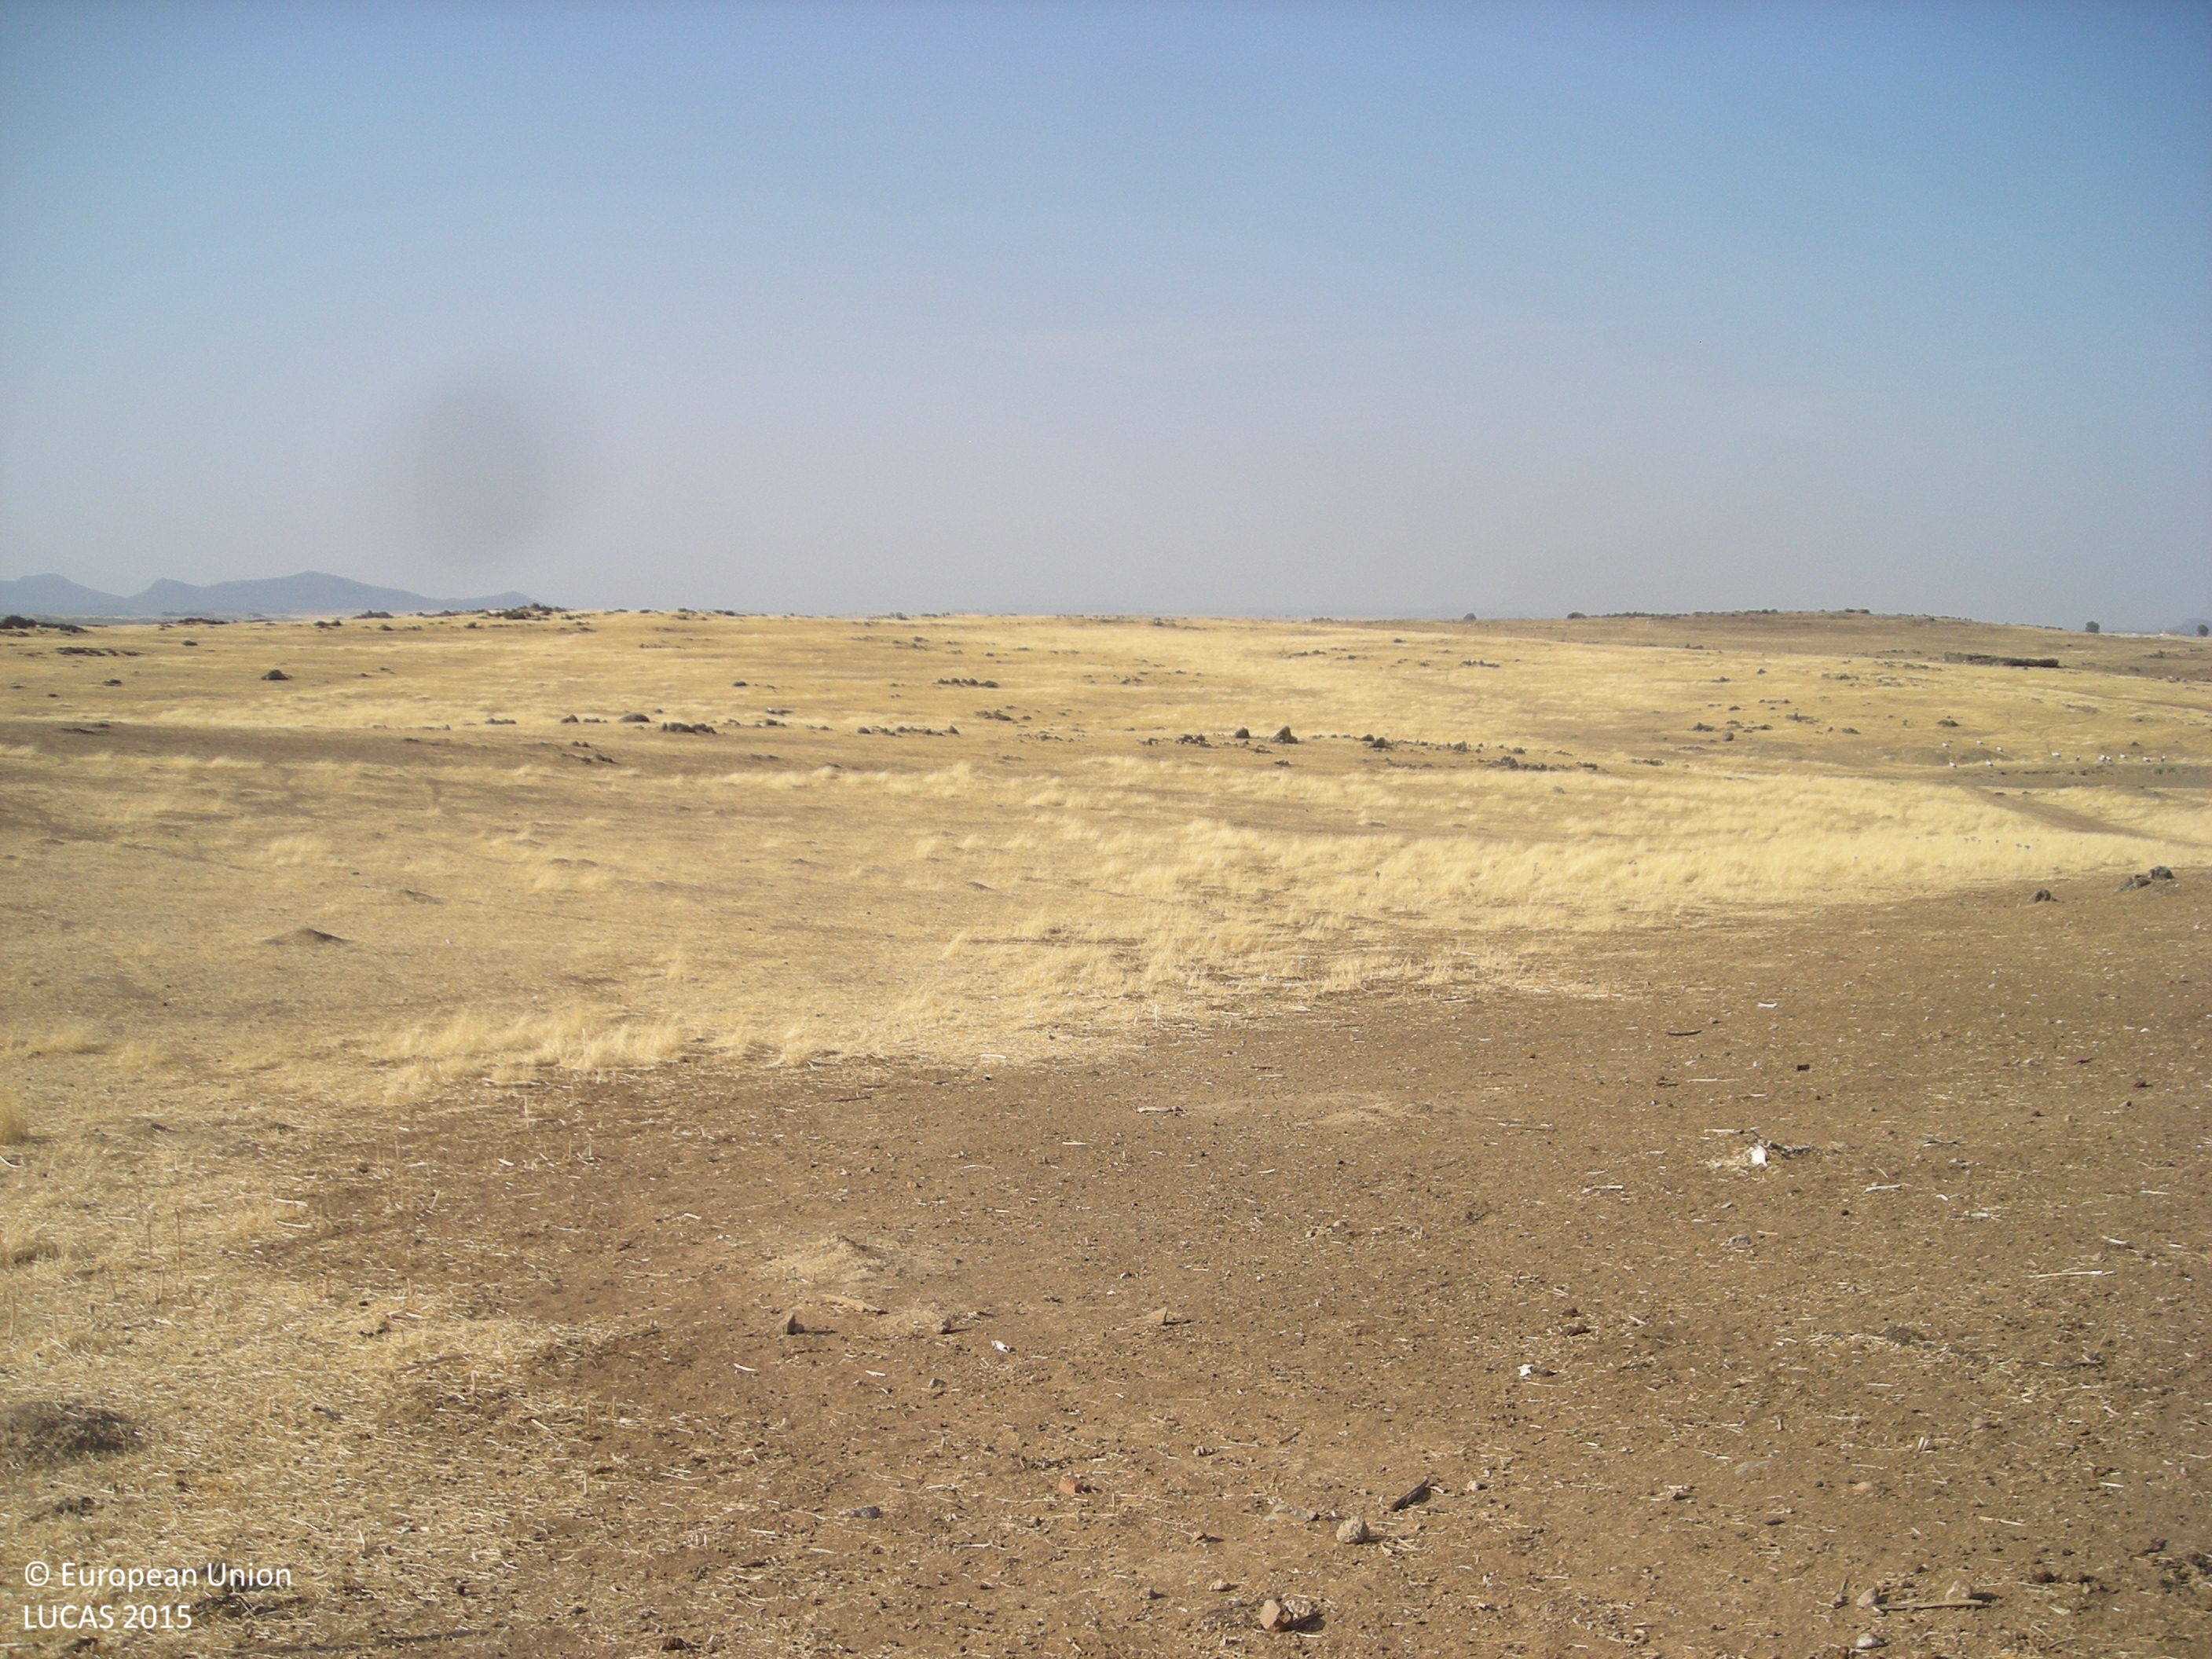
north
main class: Grassland
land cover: Grassland without tree/shrub cover
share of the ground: > 75 %
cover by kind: herbaceous plants 100 %
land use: Agriculture (excluding fallow land and kitchen gardens)
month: July
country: ES
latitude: 38.8837
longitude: -5.4772
